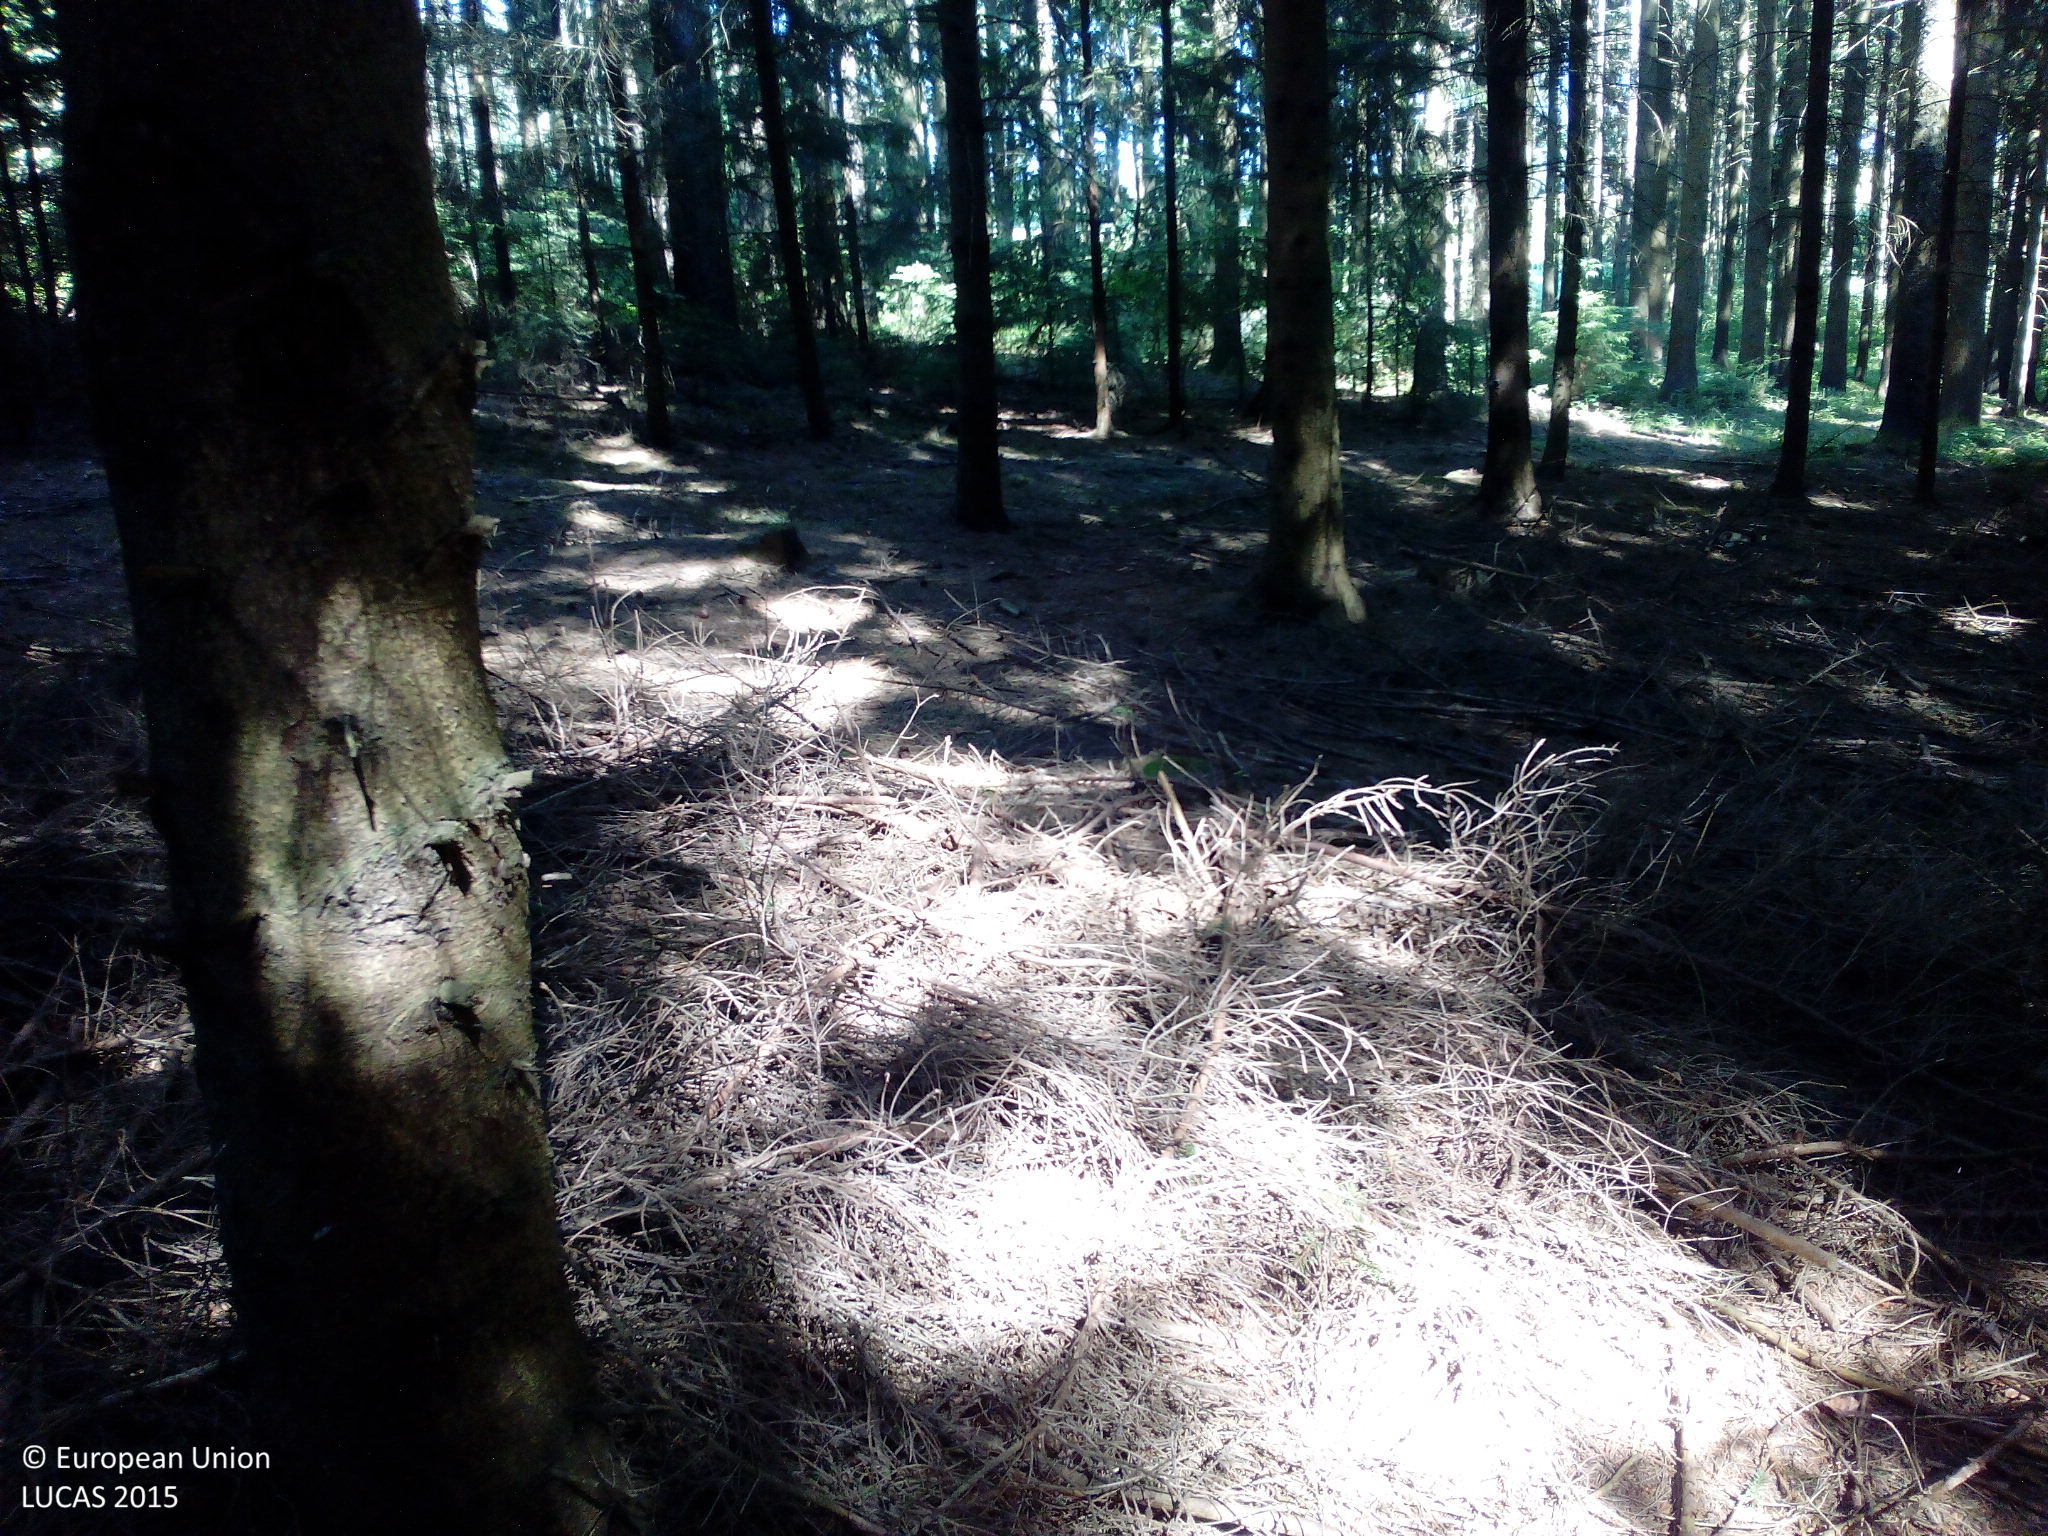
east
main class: Woodland
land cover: Spruce dominated coniferous woodland
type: hemiboreal forest and nemoral coniferous forest and mixed broadleaved-coniferous forest
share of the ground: > 75 %
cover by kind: coniferous forest trees 95 %, unconsolidated bare surface 5 %
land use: Forestry
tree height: > 5 m
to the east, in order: Spruce dominated coniferous woodland; Tracks; Spruce dominated coniferous woodland; Barley
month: June
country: DE
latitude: 48.6540
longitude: 12.0762
